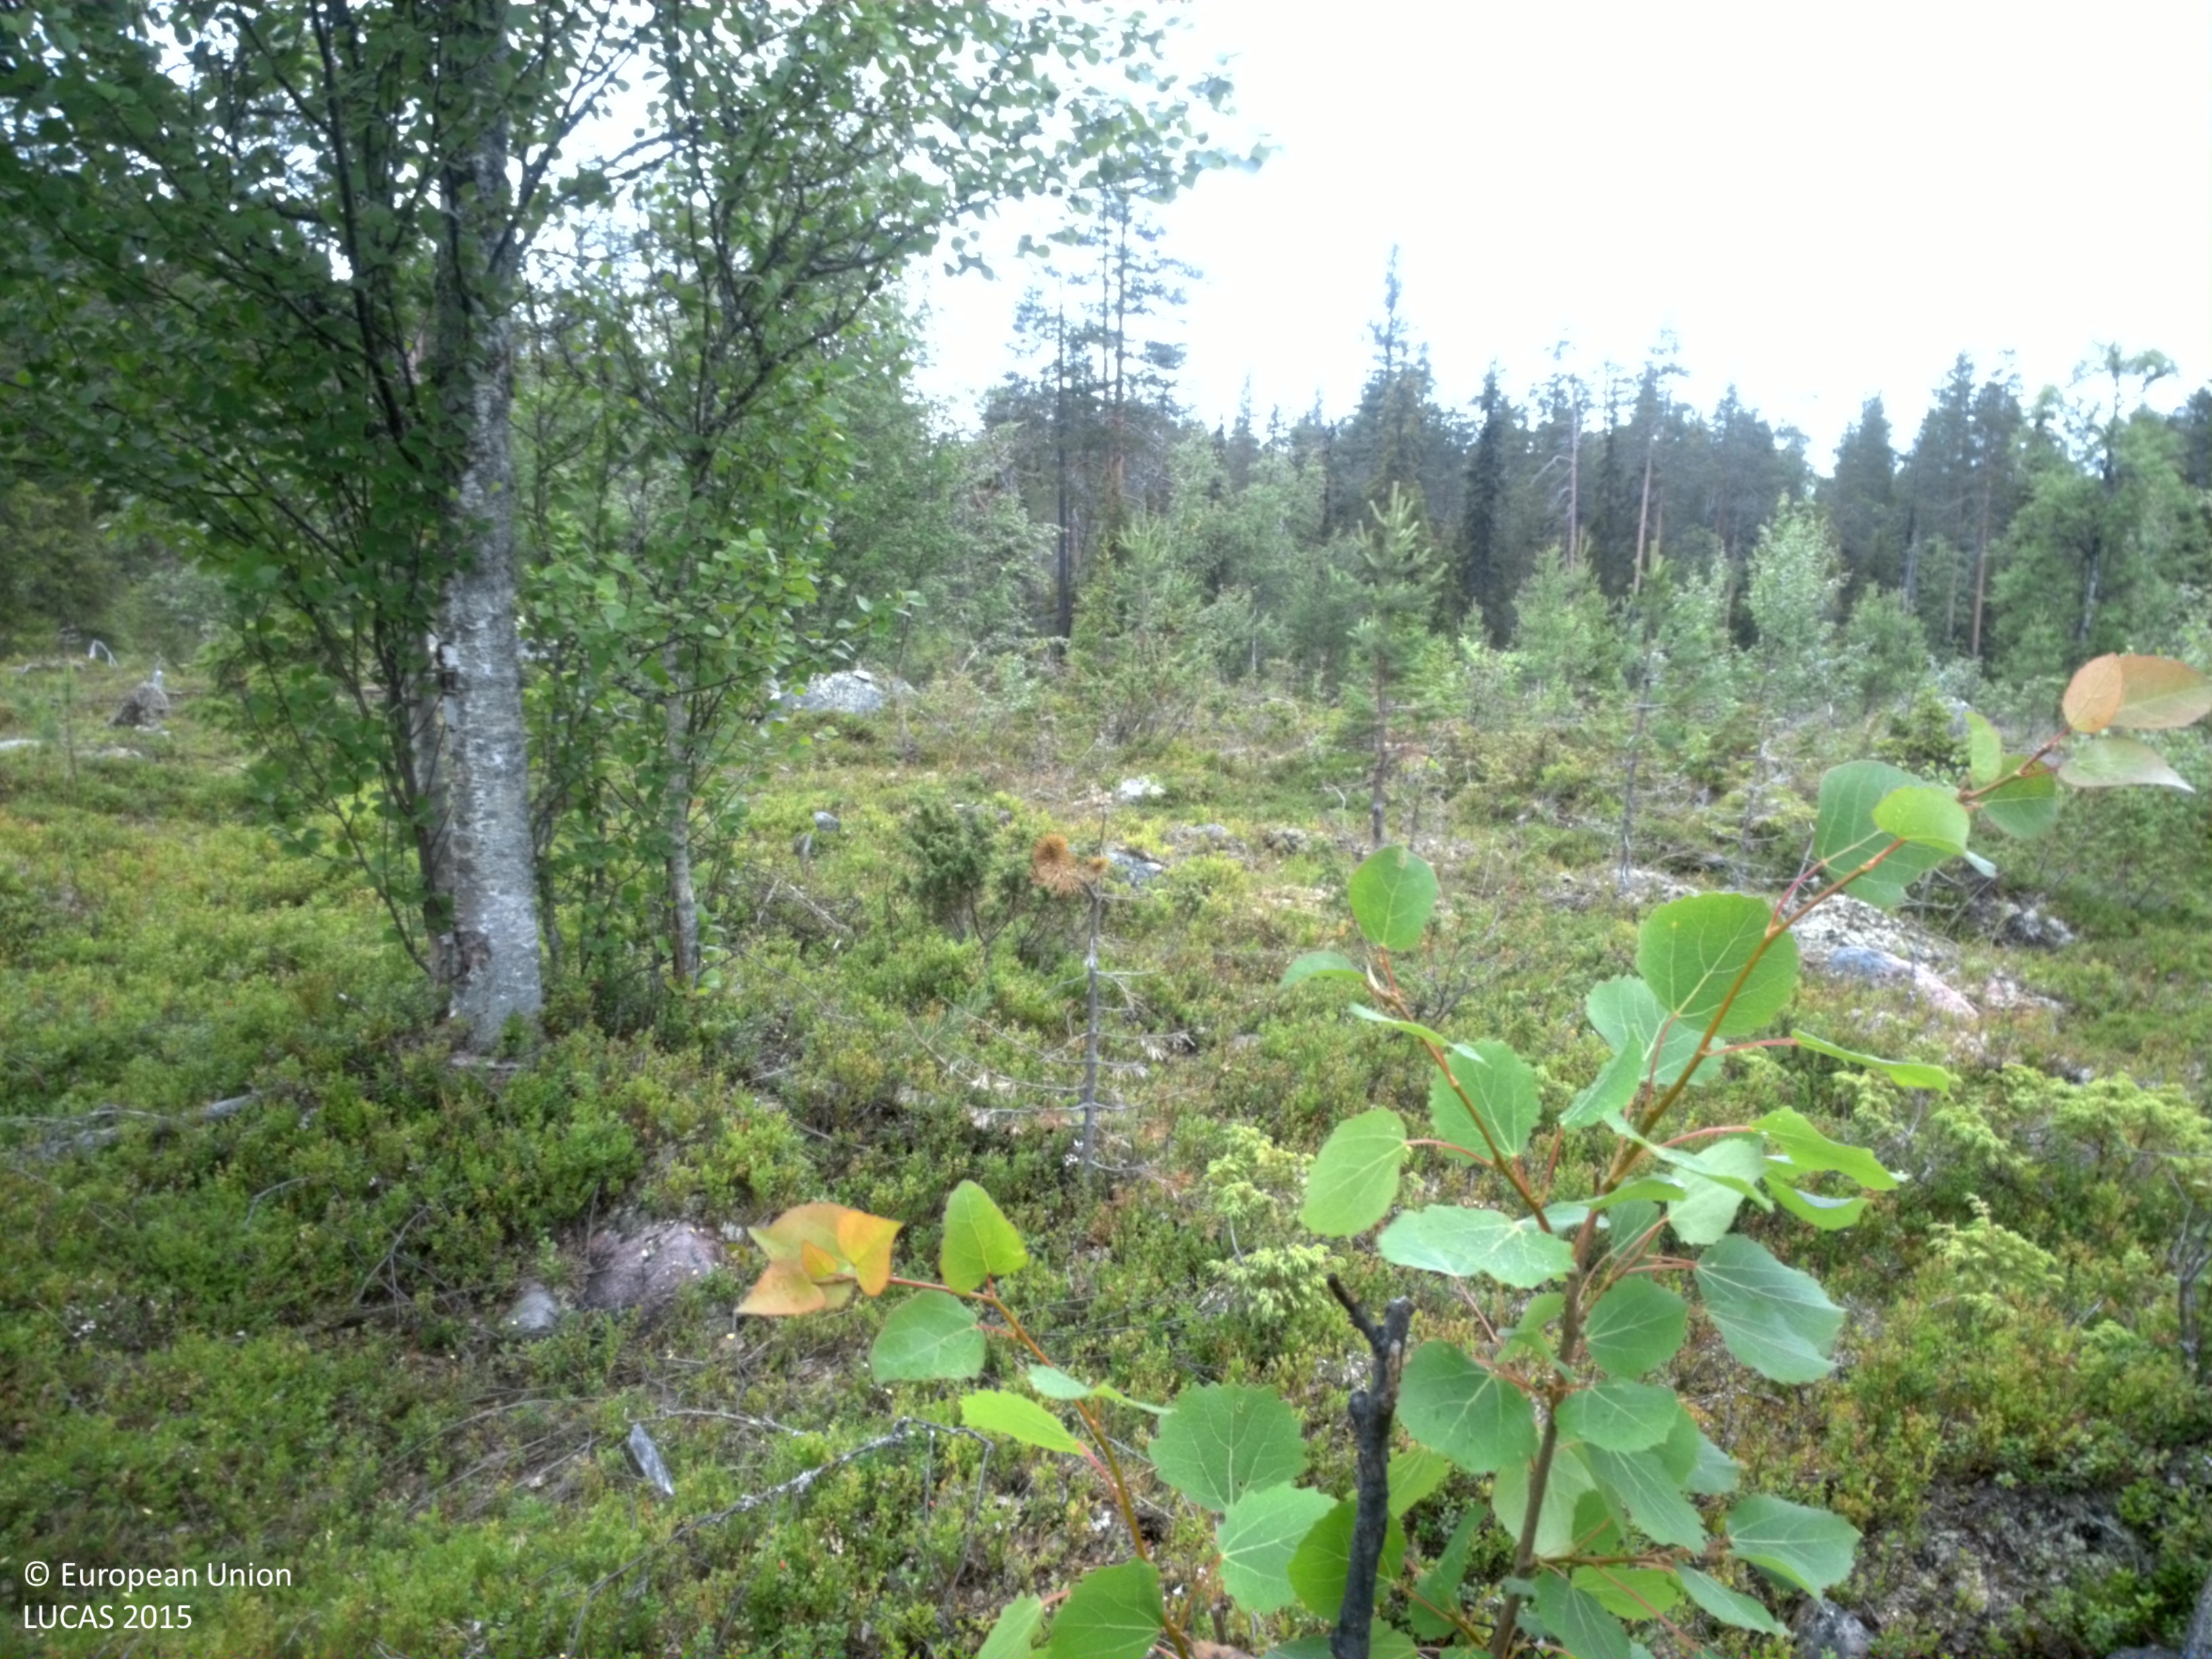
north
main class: Woodland
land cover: Pine dominated mixed woodland
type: boreal forest
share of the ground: 10 - 25 %
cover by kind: shrubs 80 %, coniferous forest trees 10 %, broadleaved forest trees 5 %, consolidated bare surface 5 %
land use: Forestry
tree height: < 5 m
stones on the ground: > 50 %
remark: Clear cut
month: August
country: SE
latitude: 66.1518
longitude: 19.8650
